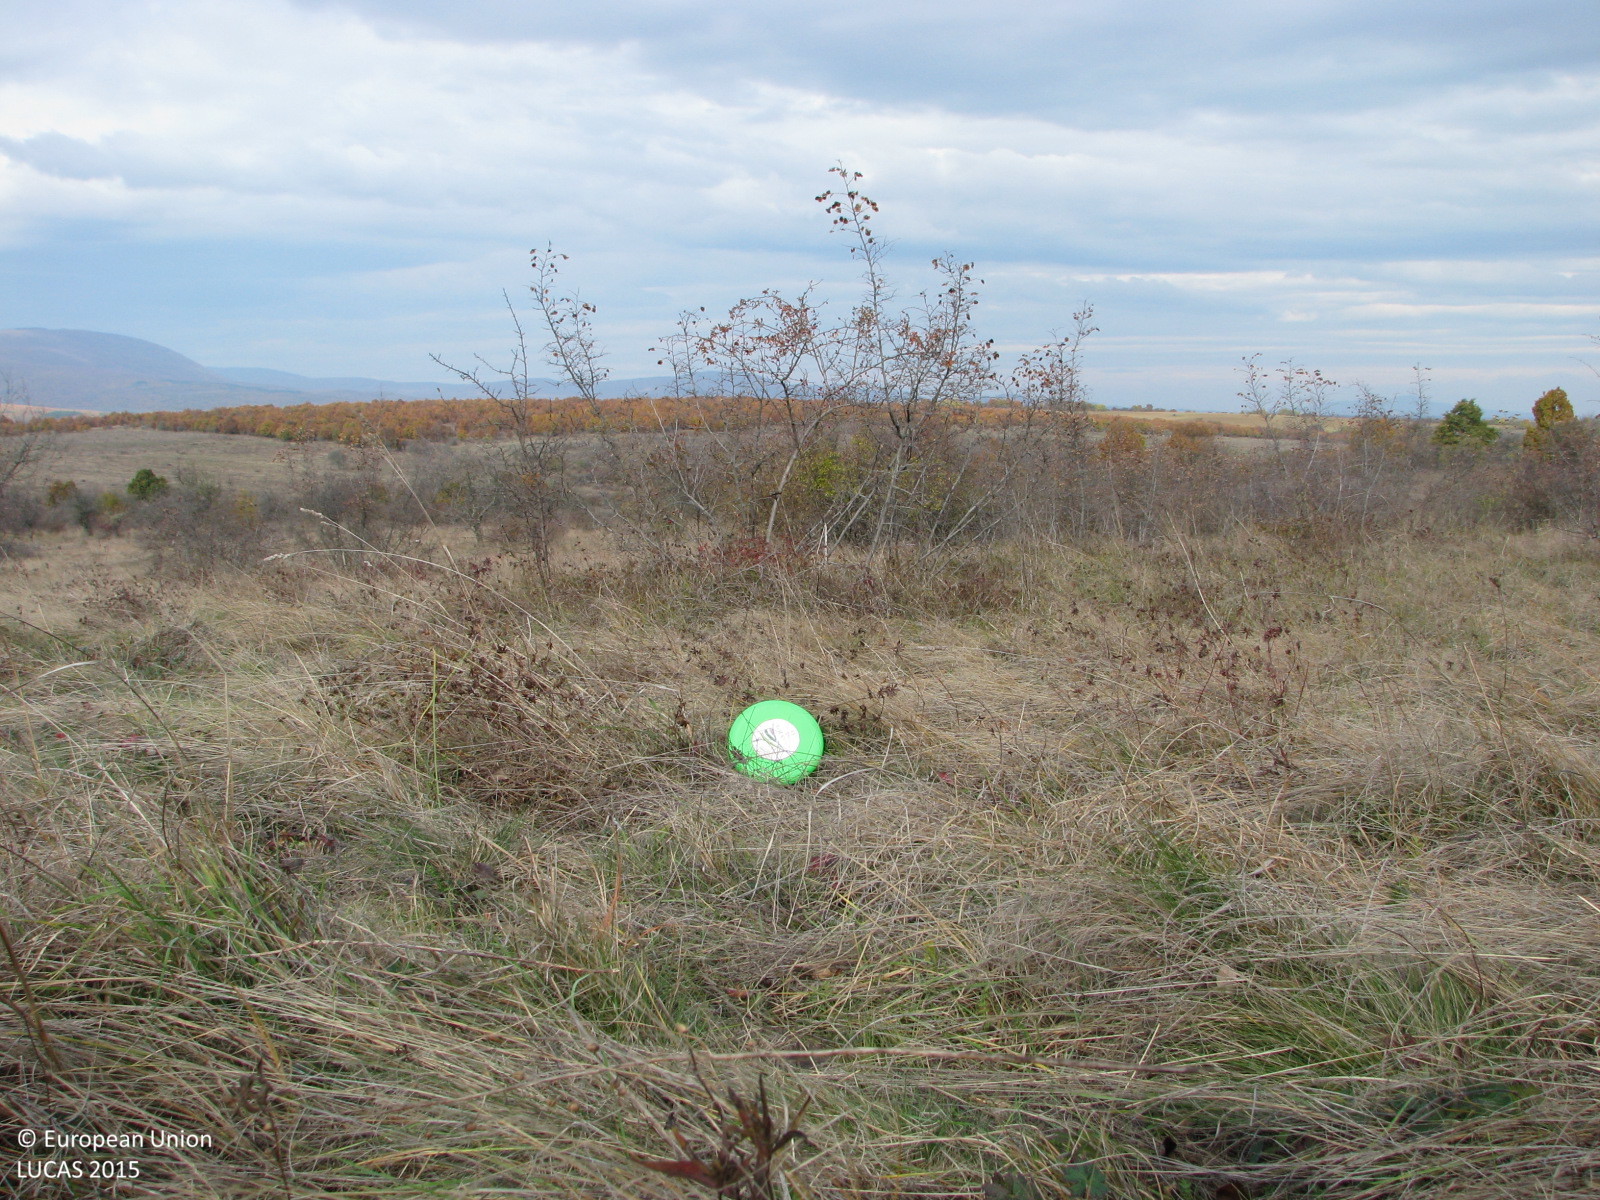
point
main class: Grassland
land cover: Grassland with sparse tree/shrub cover
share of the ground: > 75 %
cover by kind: herbaceous plants 85 %, shrubs 10 %, broadleaved forest trees 5 %
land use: Agriculture (excluding fallow land and kitchen gardens)
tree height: < 5 m
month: November
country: BG
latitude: 41.9417
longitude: 26.4516
